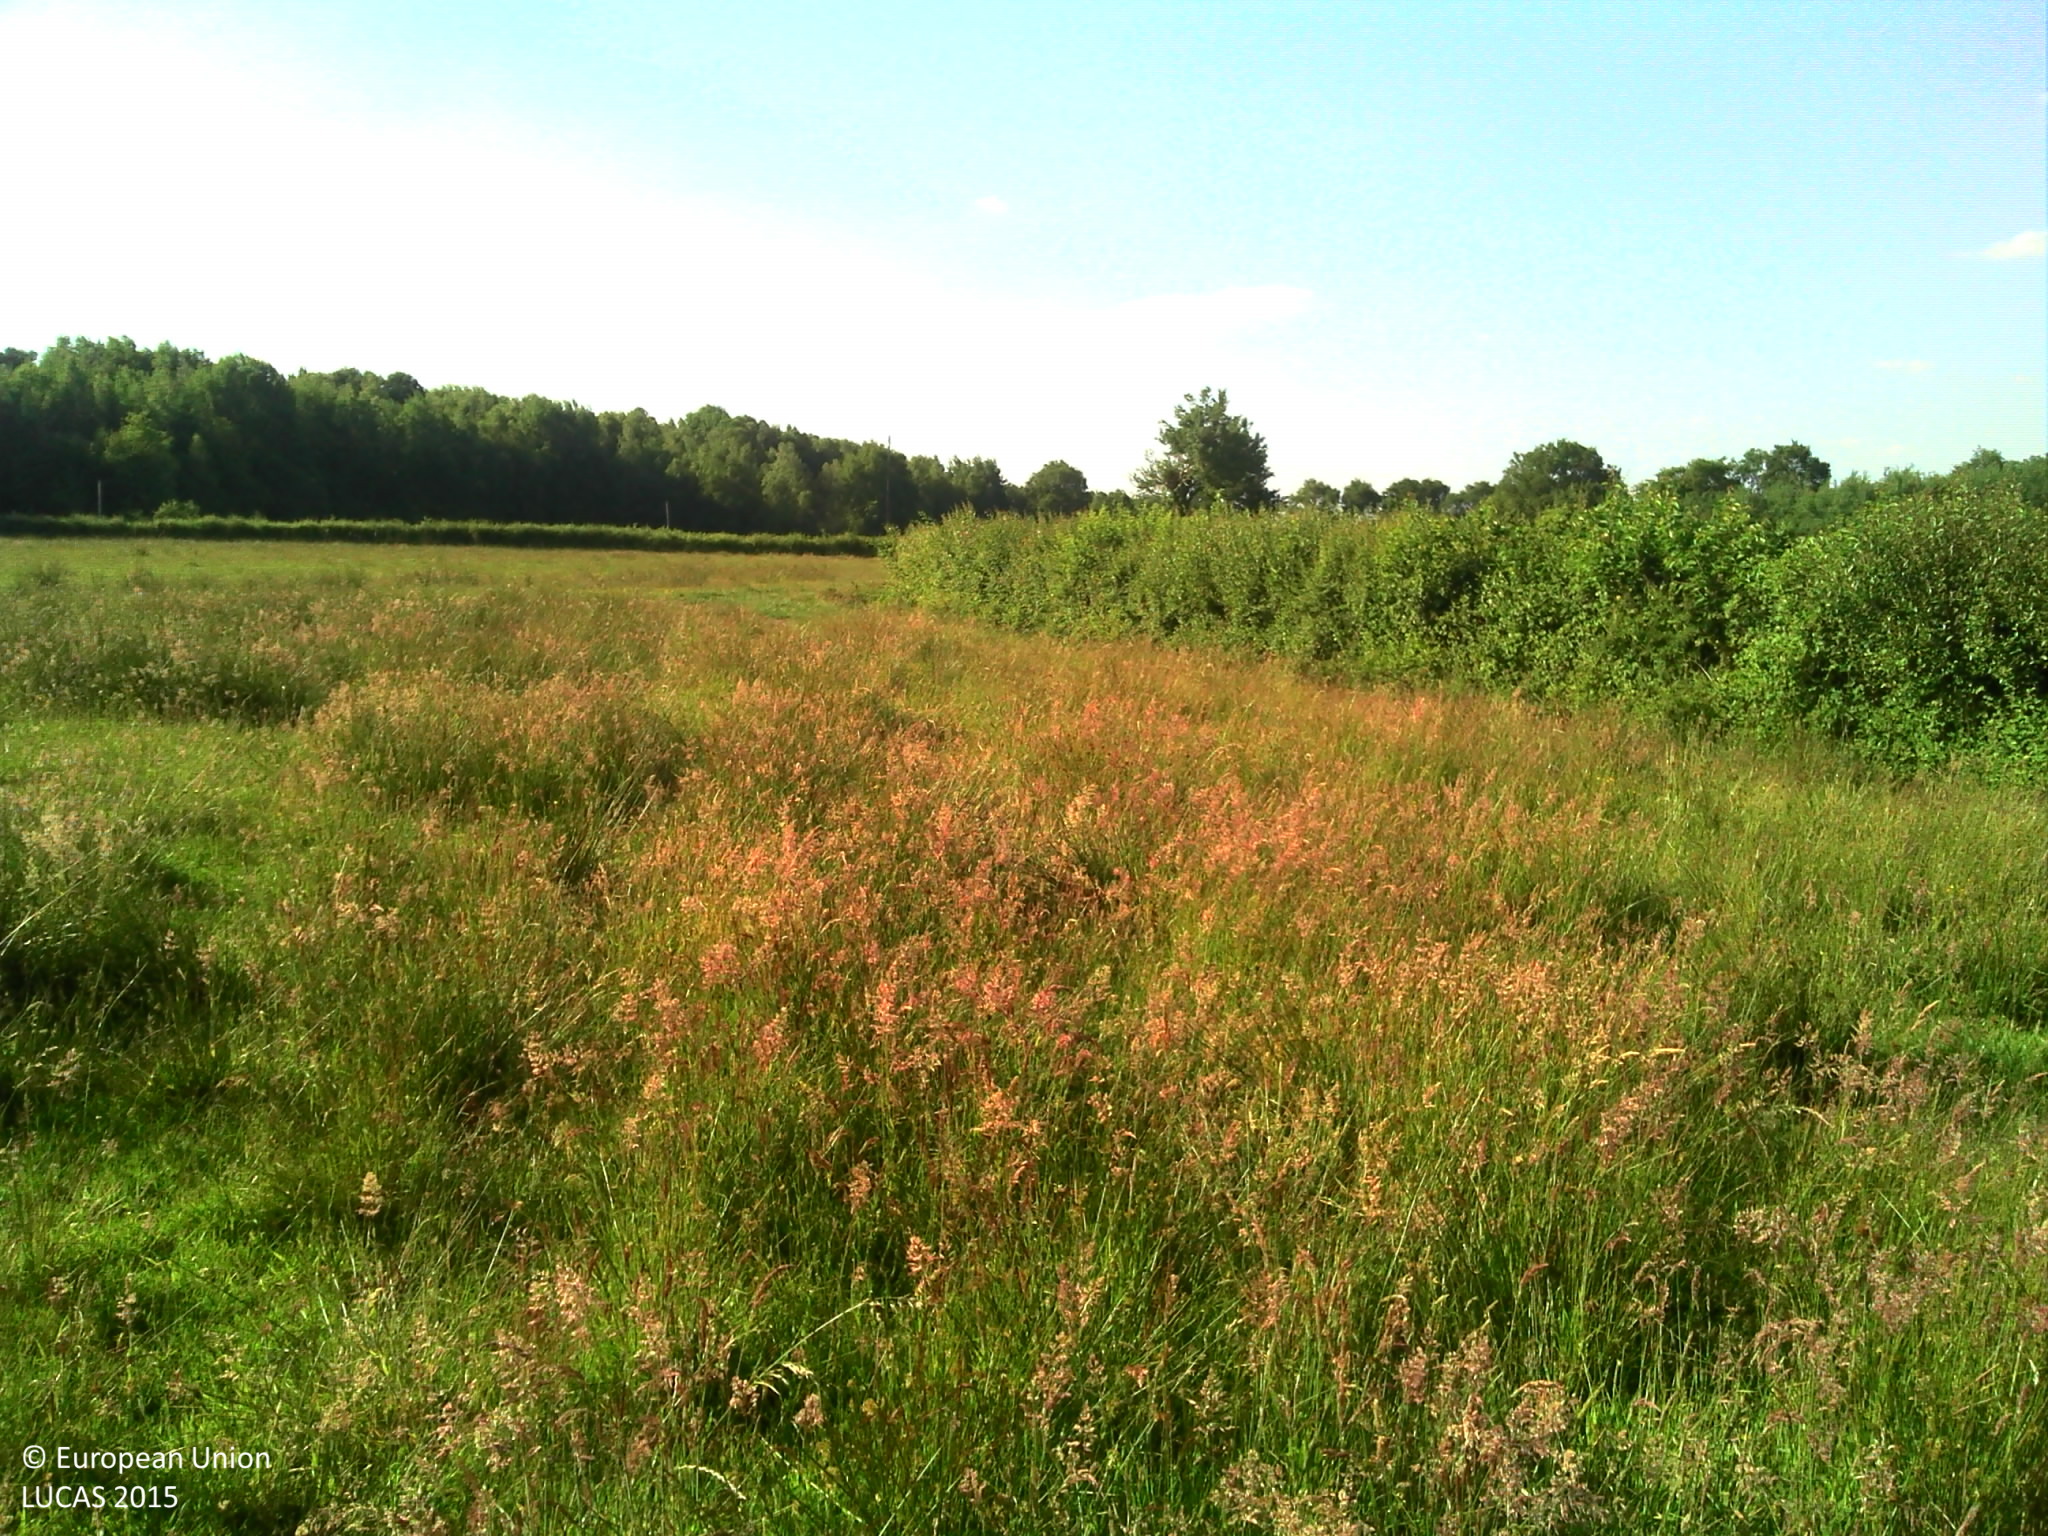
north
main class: Grassland
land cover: Grassland without tree/shrub cover
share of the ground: > 75 %
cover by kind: herbaceous plants 100 %
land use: Agriculture (excluding fallow land and kitchen gardens)
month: June
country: FR
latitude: 47.2886
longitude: 2.0967
